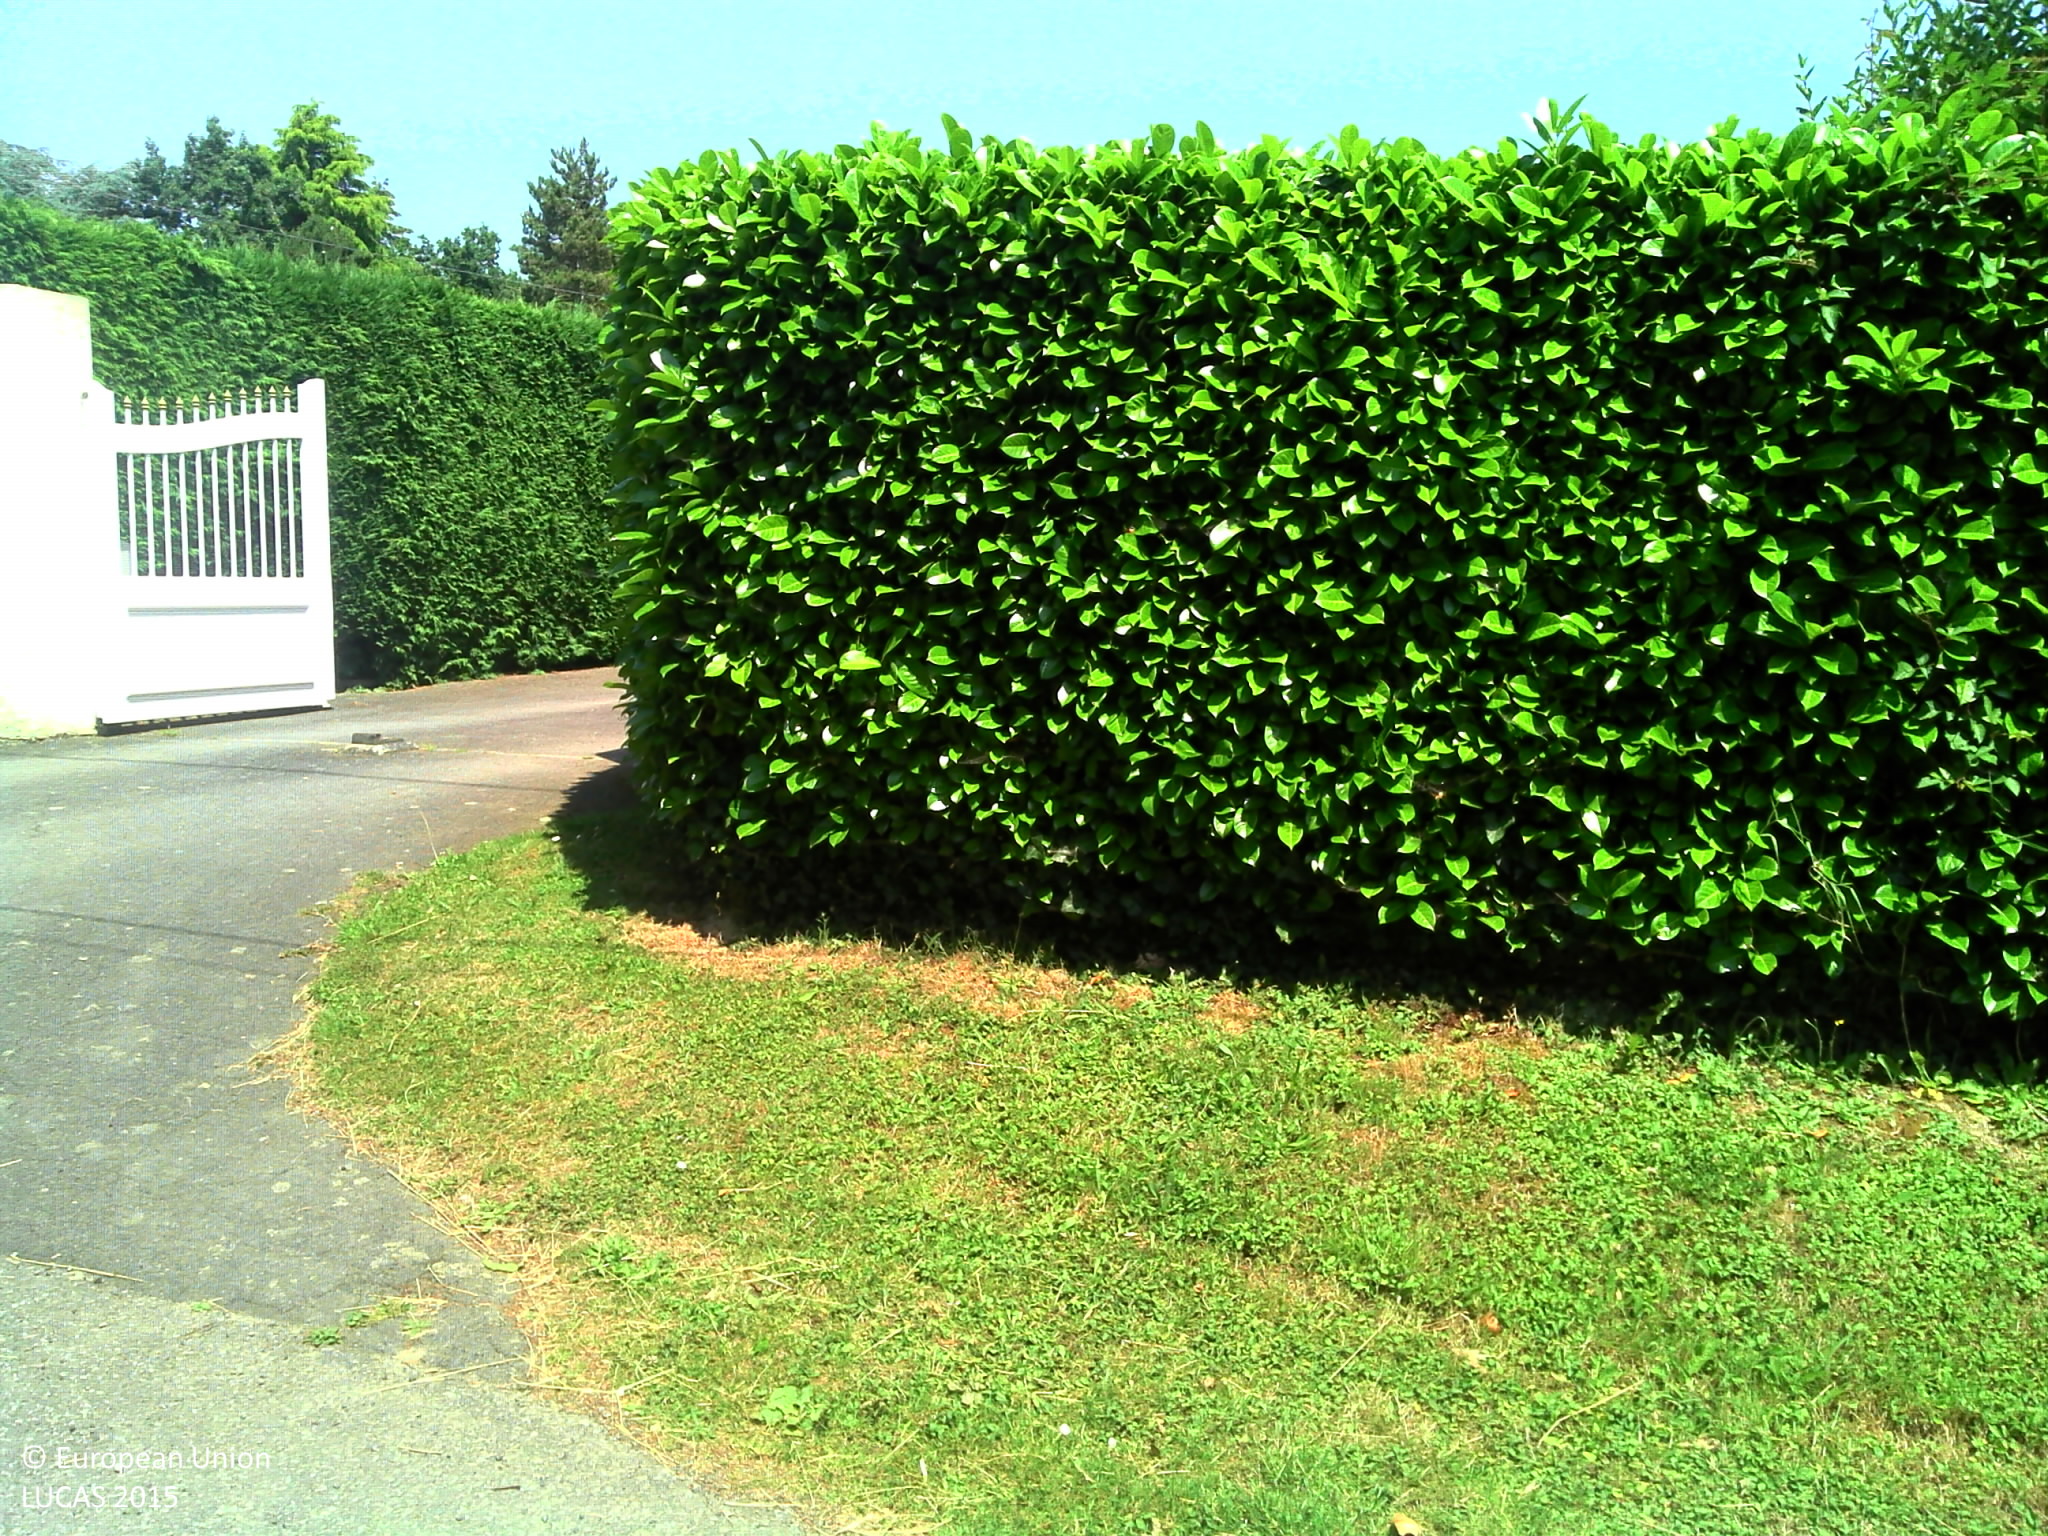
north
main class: Grassland
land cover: Grassland with sparse tree/shrub cover
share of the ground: > 75 %
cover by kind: herbaceous plants 95 %, broadleaved forest trees 5 %
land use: Residential
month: June
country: FR
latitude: 48.0427
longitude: -1.6229
